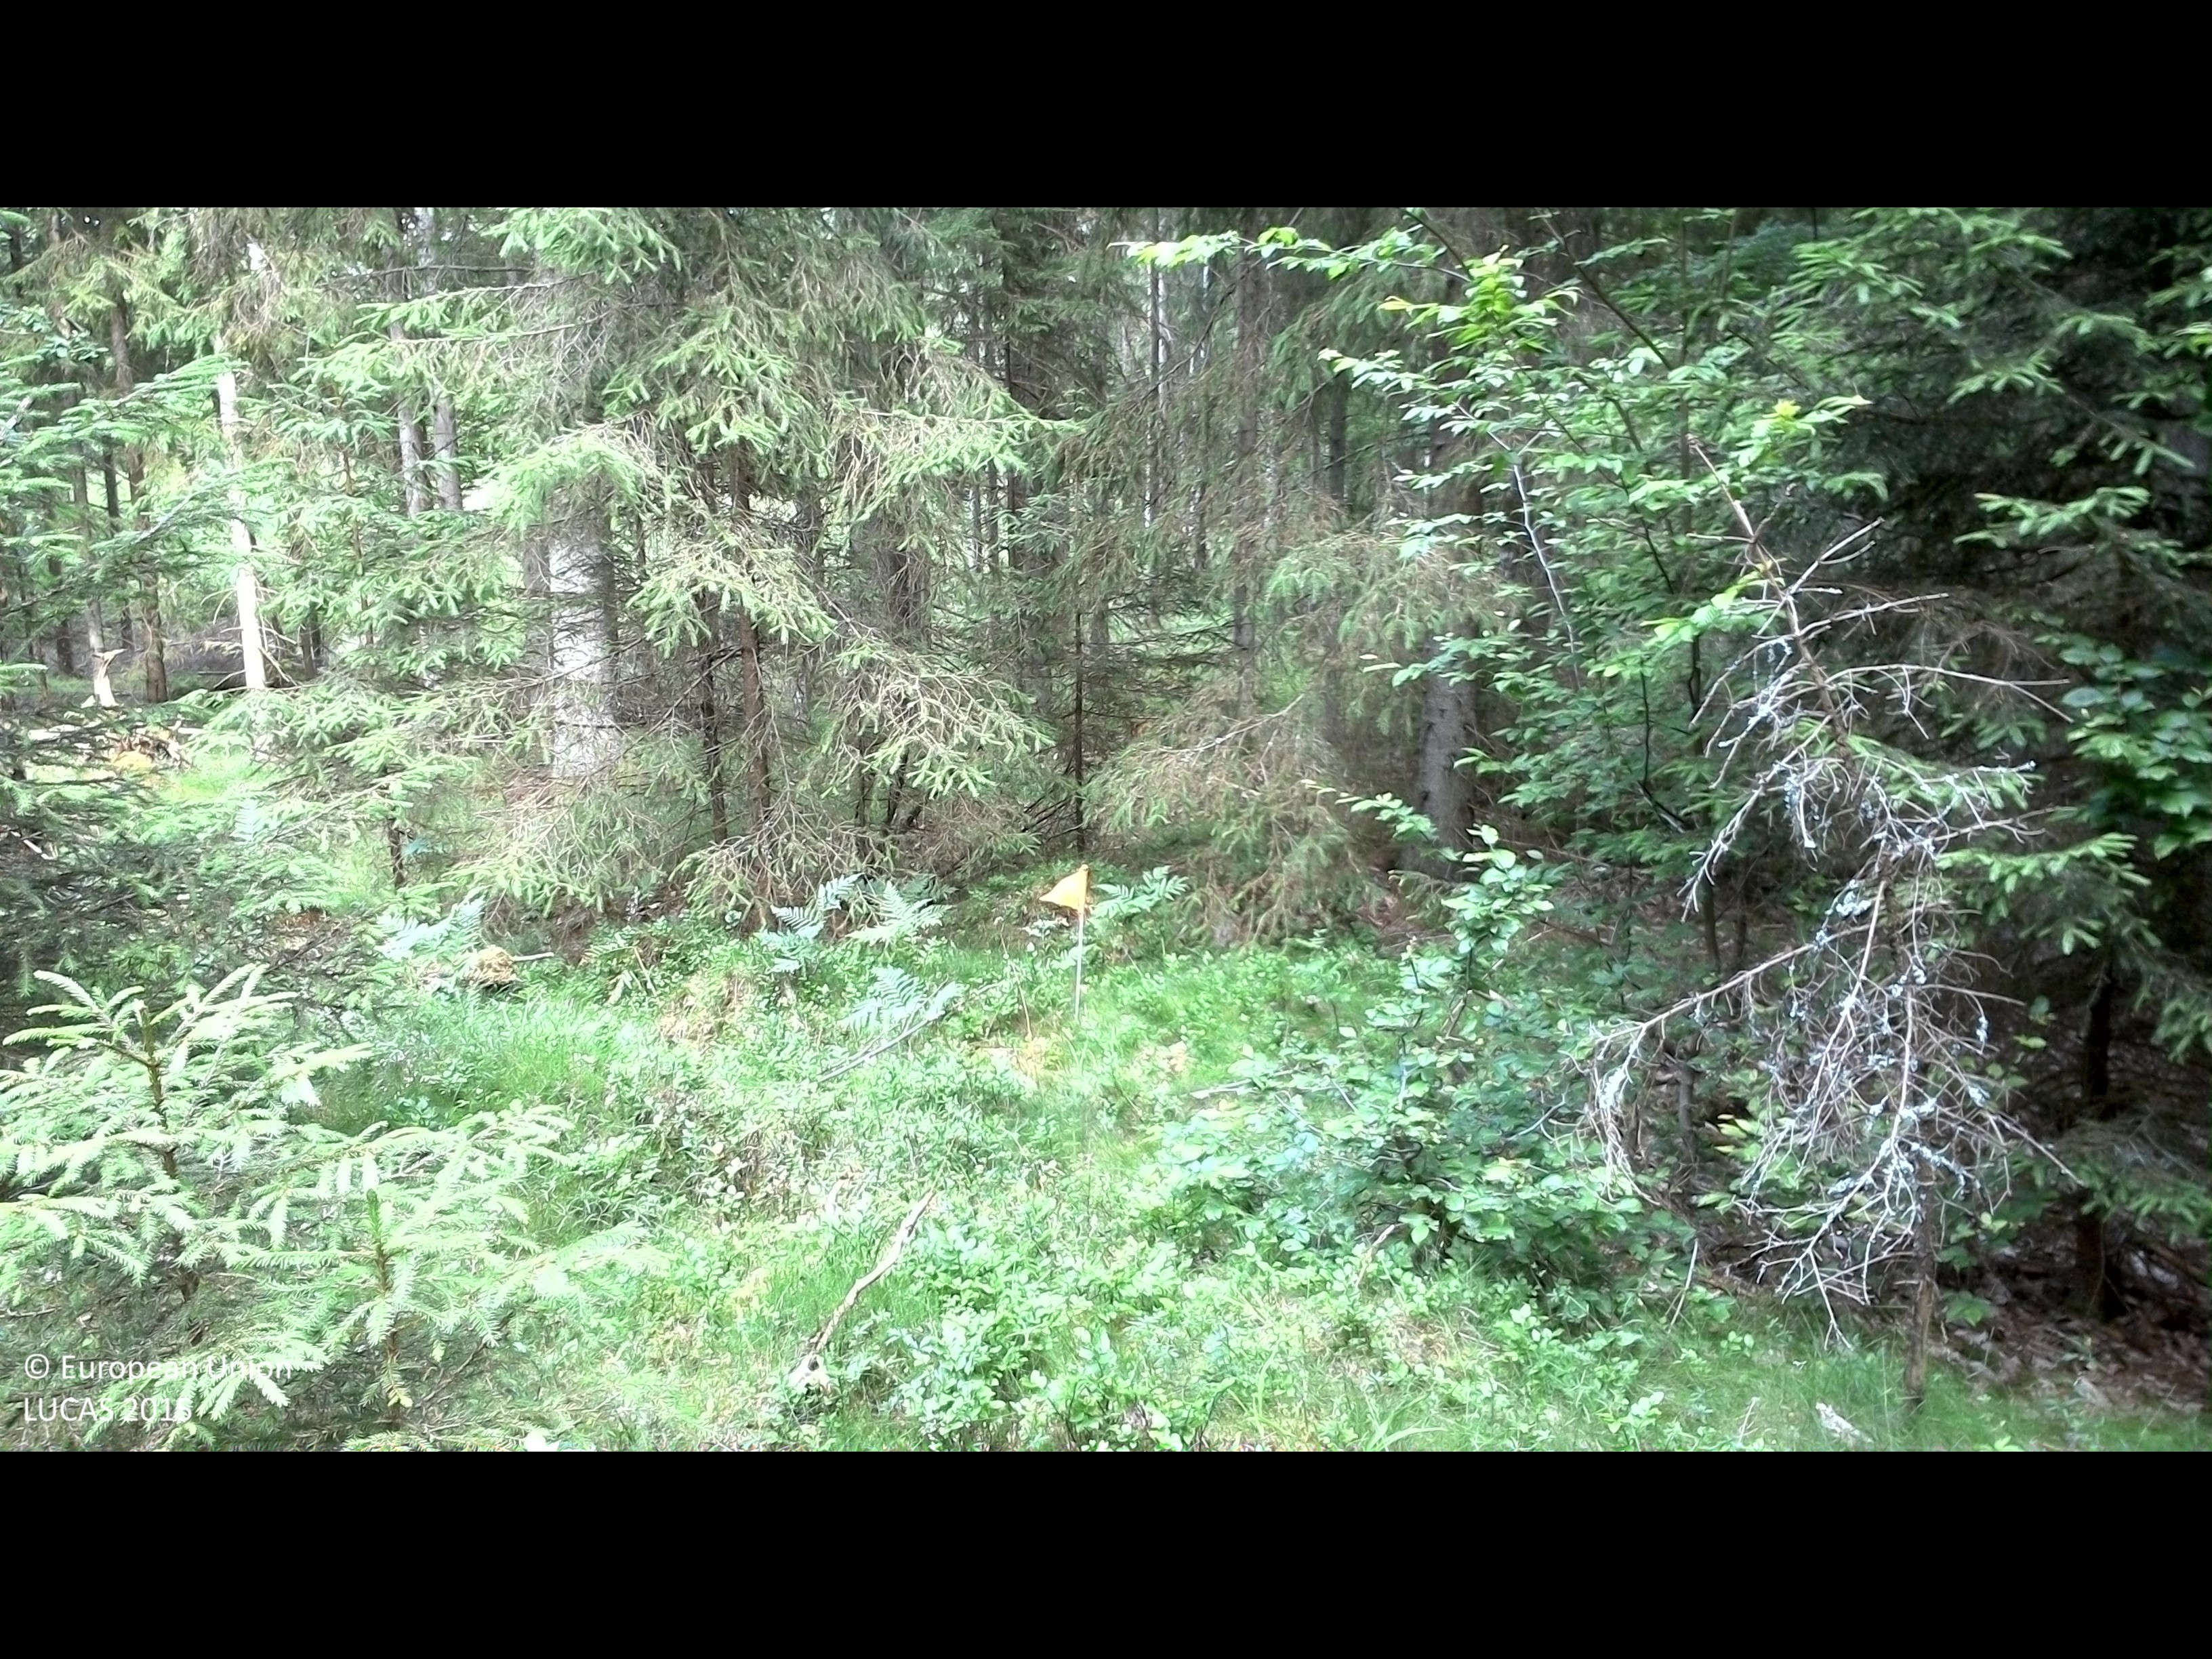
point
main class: Woodland
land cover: Spruce dominated coniferous woodland
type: boreal forest
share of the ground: 50 - 75 %
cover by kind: coniferous forest trees 50 %, shrubs 20 %, herbaceous plants 15 %, lichens and mosses 10 %, broadleaved forest trees 5 %
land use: Forestry
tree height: > 5 m
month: July
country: SE
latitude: 56.3311
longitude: 15.2876
